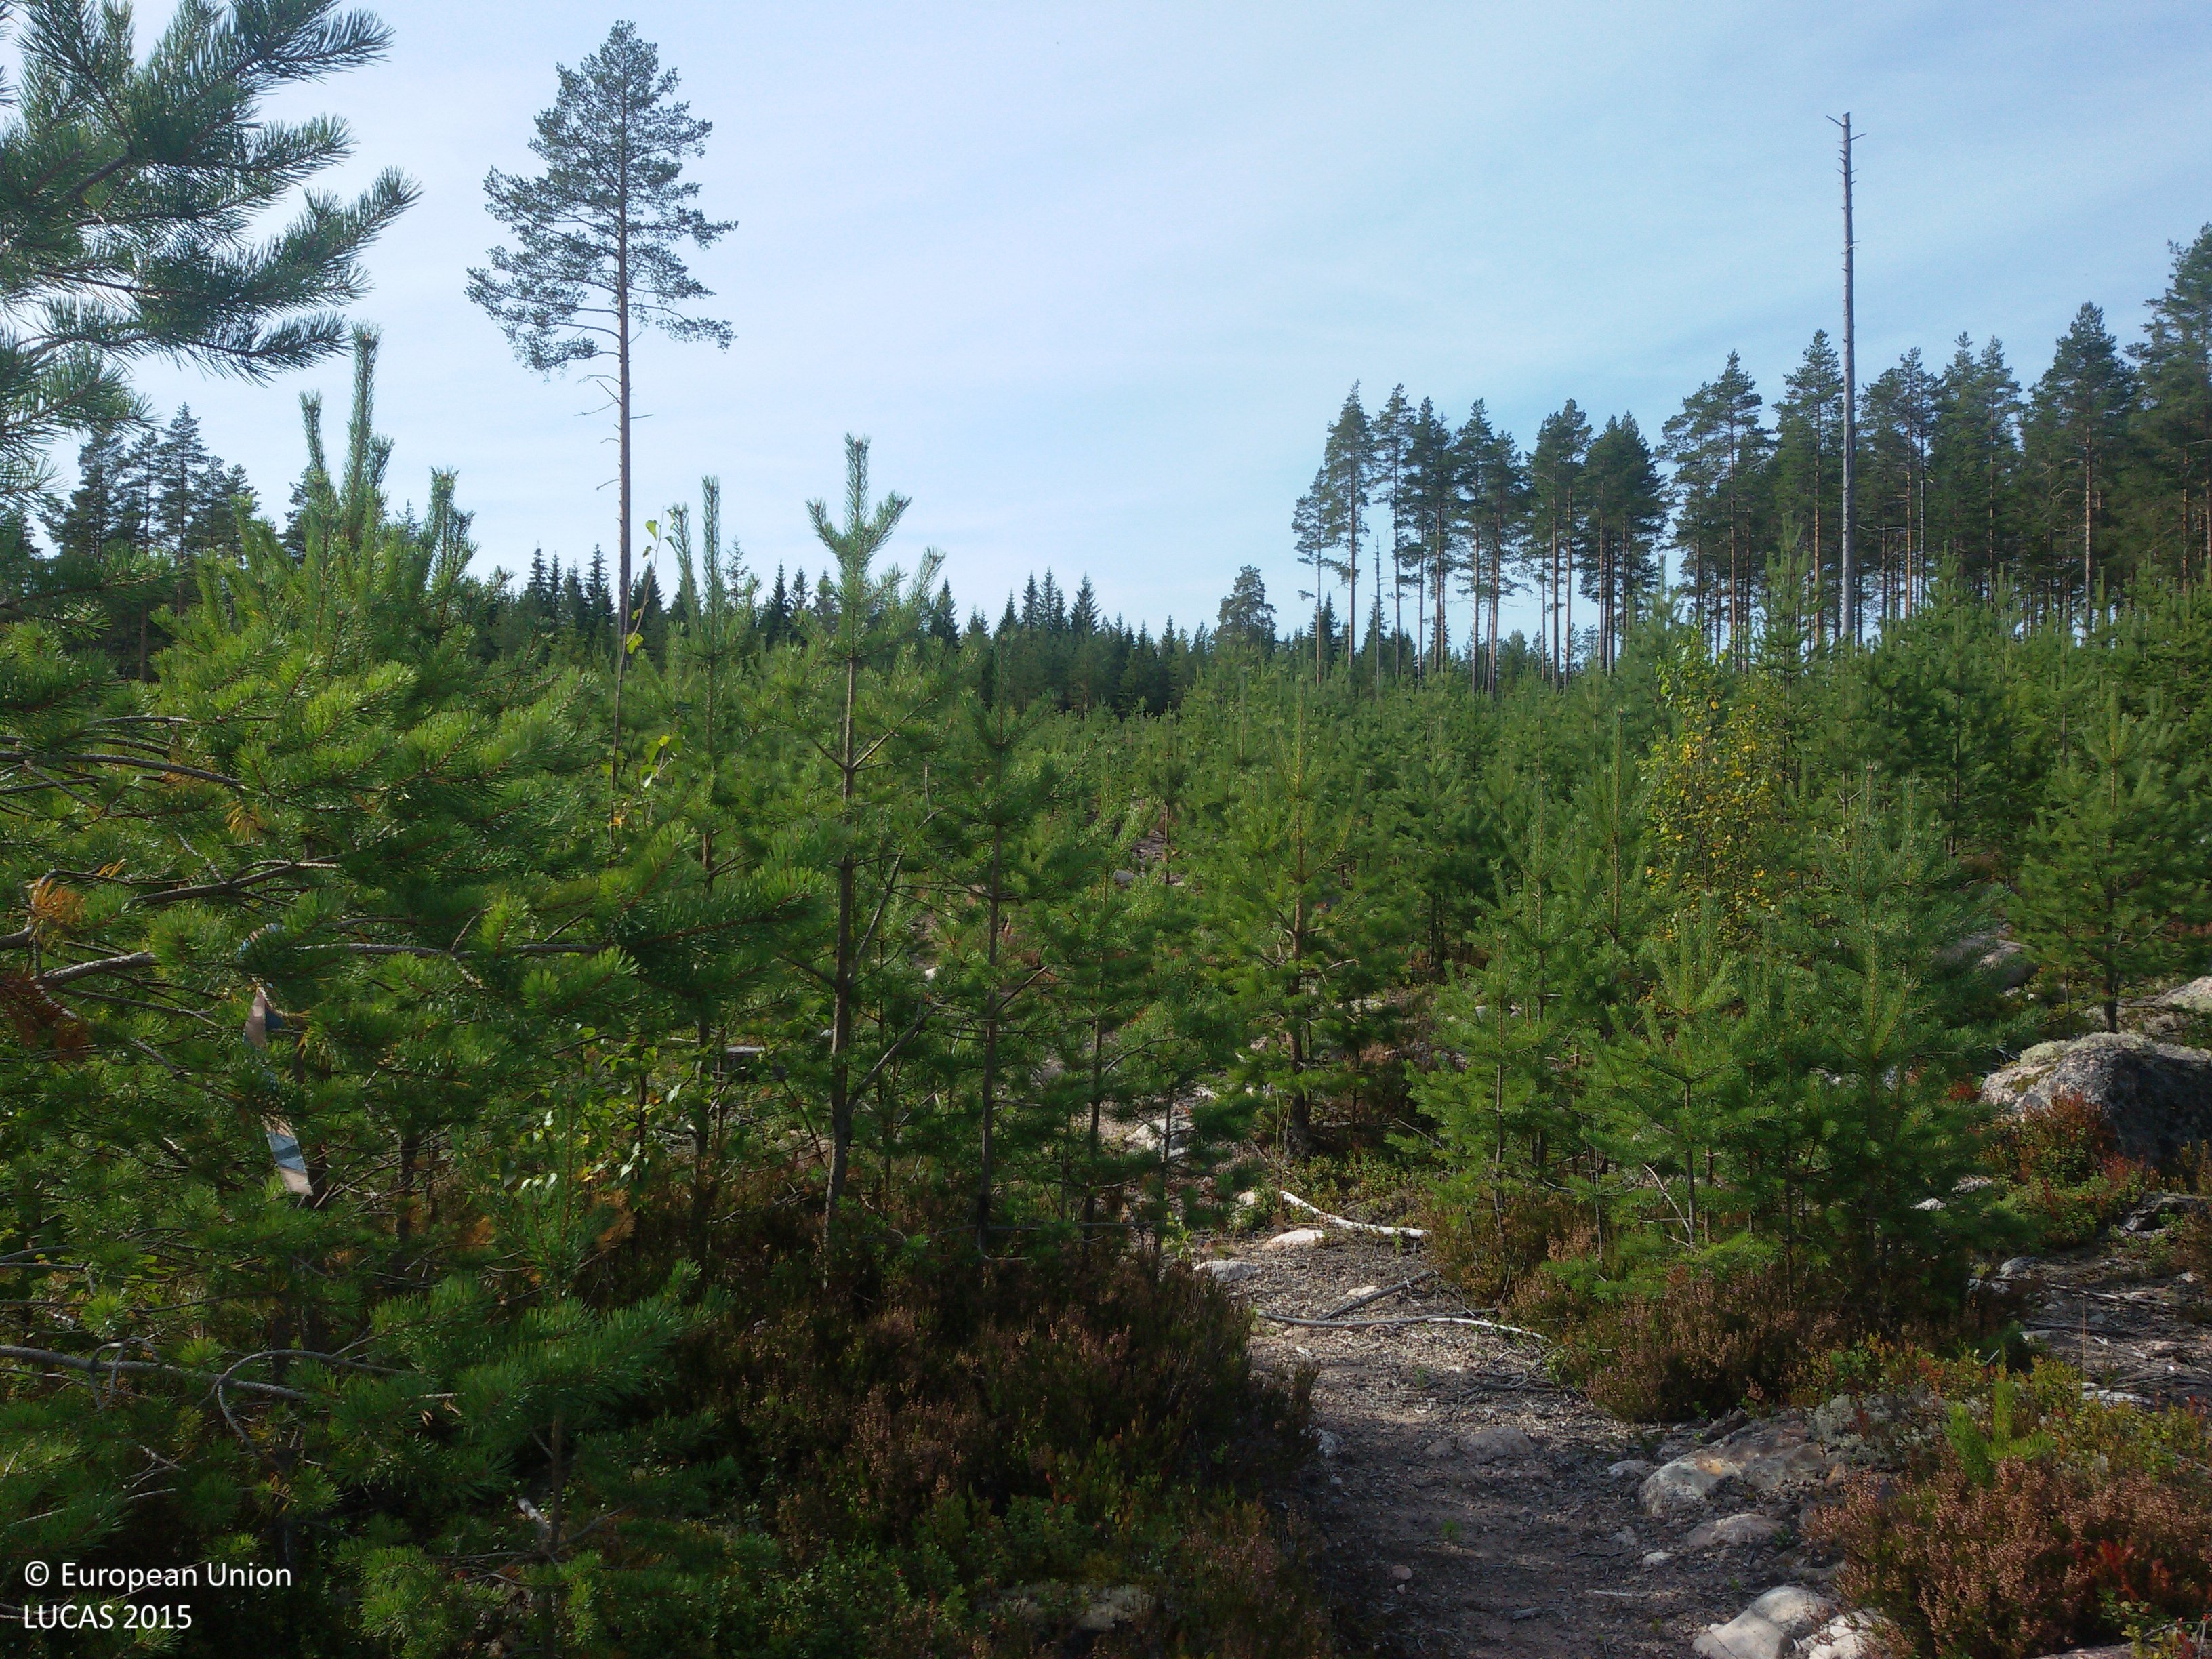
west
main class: Woodland
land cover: Pine dominated coniferous woodland
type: boreal forest
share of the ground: 50 - 75 %
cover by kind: coniferous forest trees 70 %, lichens and mosses 15 %, shrubs 10 %, herbaceous plants 5 %
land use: Forestry
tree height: < 5 m
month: September
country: SE
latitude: 61.0185
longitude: 15.3328
